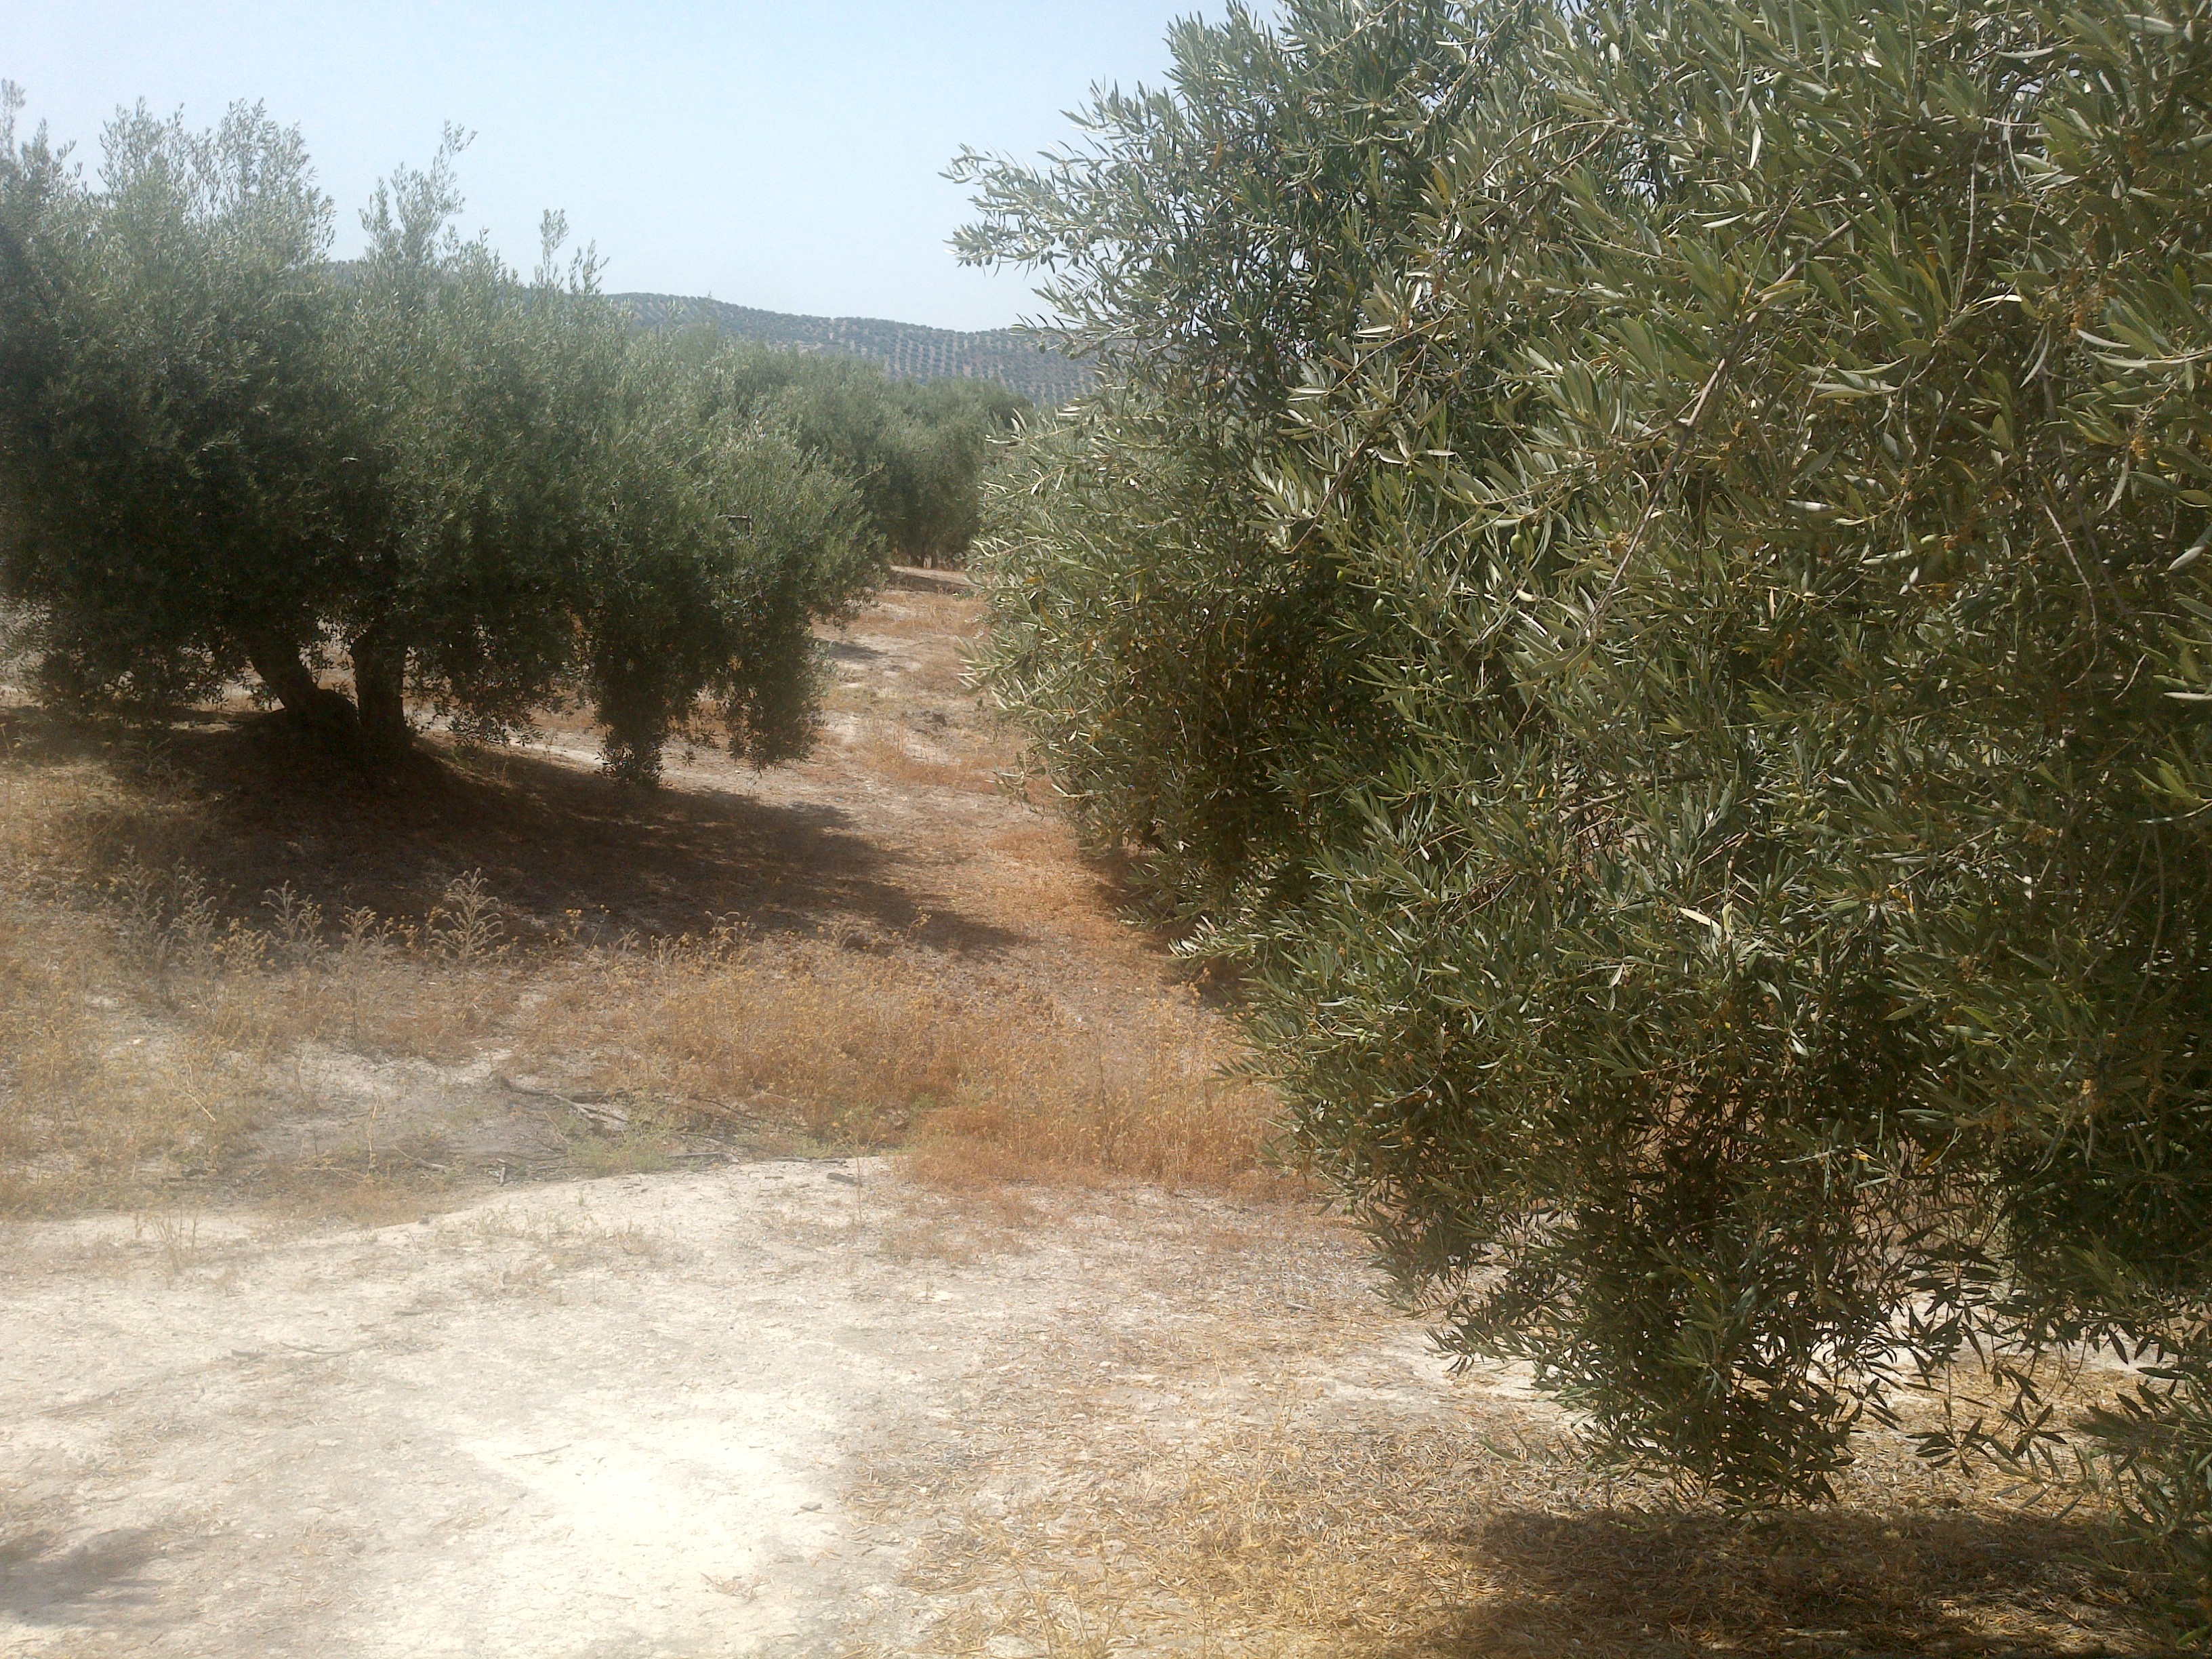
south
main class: Cropland
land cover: Olive groves
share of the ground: 50 - 75 %
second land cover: Spontaneously vegetated surfaces
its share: 10 - 25 %
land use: Agriculture (excluding fallow land and kitchen gardens)
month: June
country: ES
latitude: 37.6493
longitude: -4.2050
